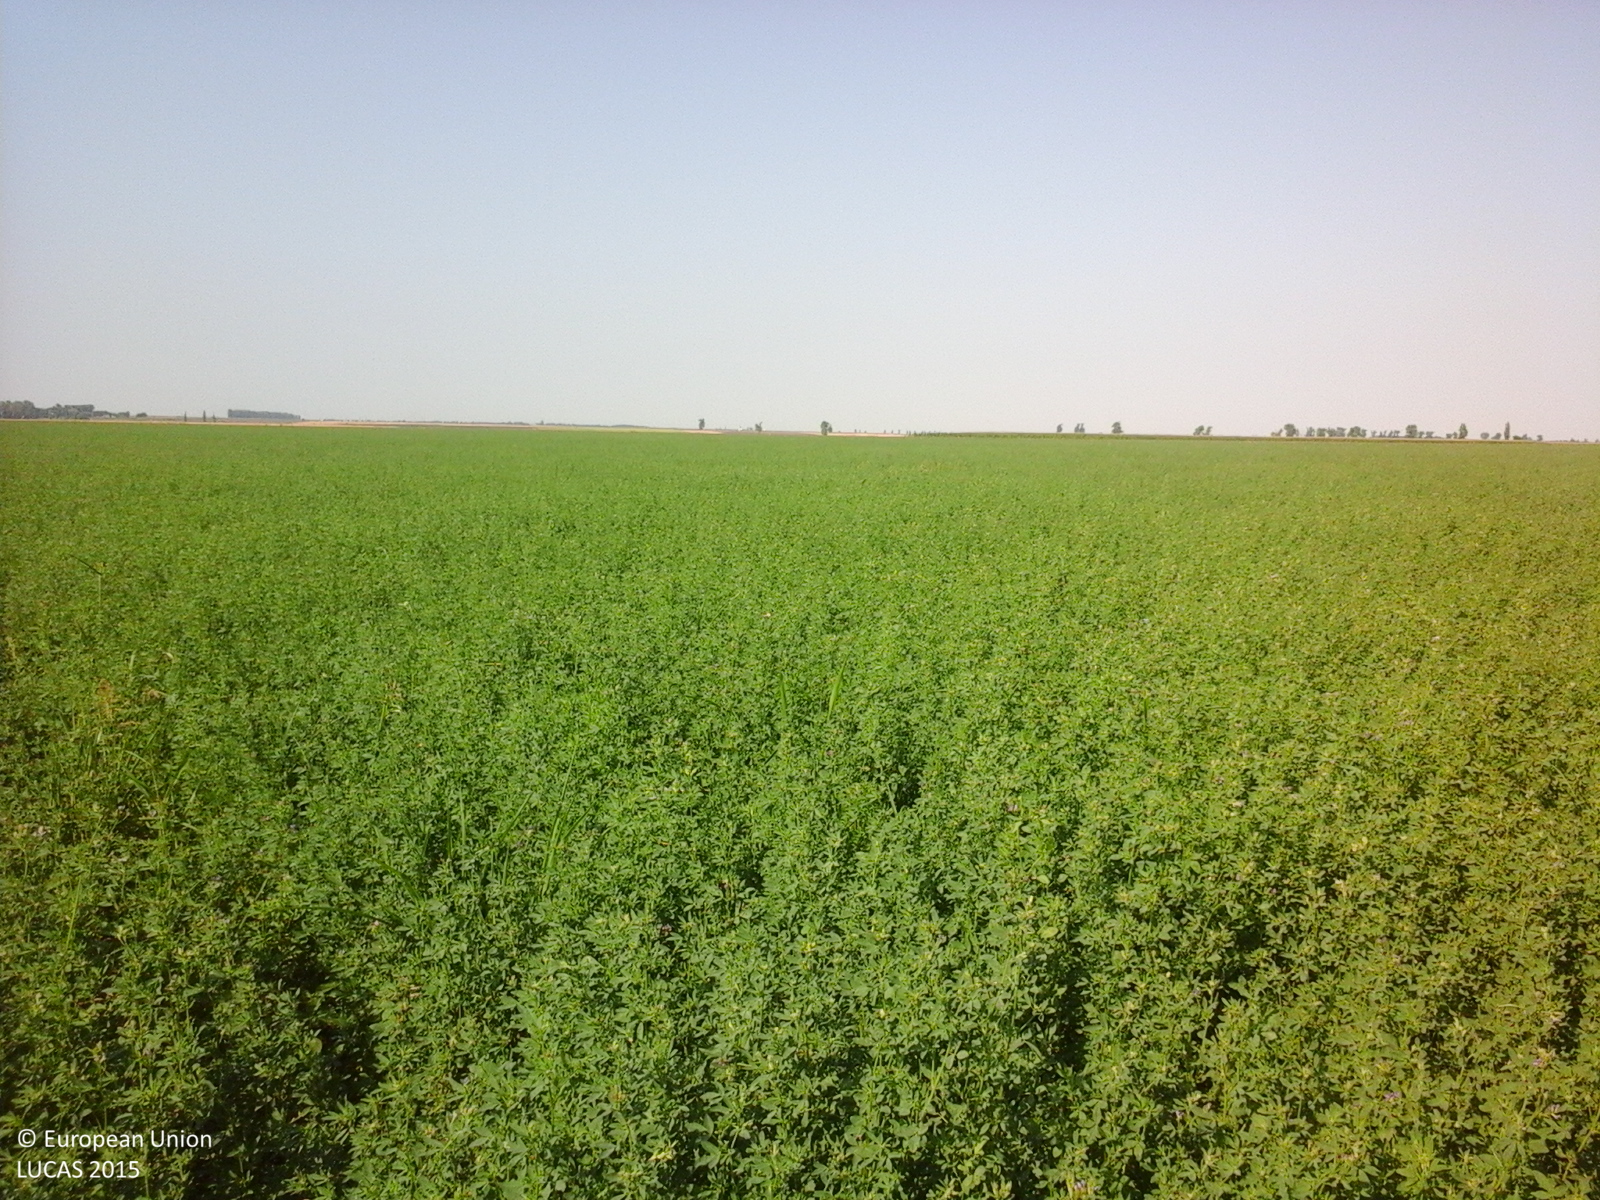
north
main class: Cropland
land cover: Lucerne
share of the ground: > 75 %
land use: Agriculture (excluding fallow land and kitchen gardens)
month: July
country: RO
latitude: 44.7080
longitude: 27.2925
